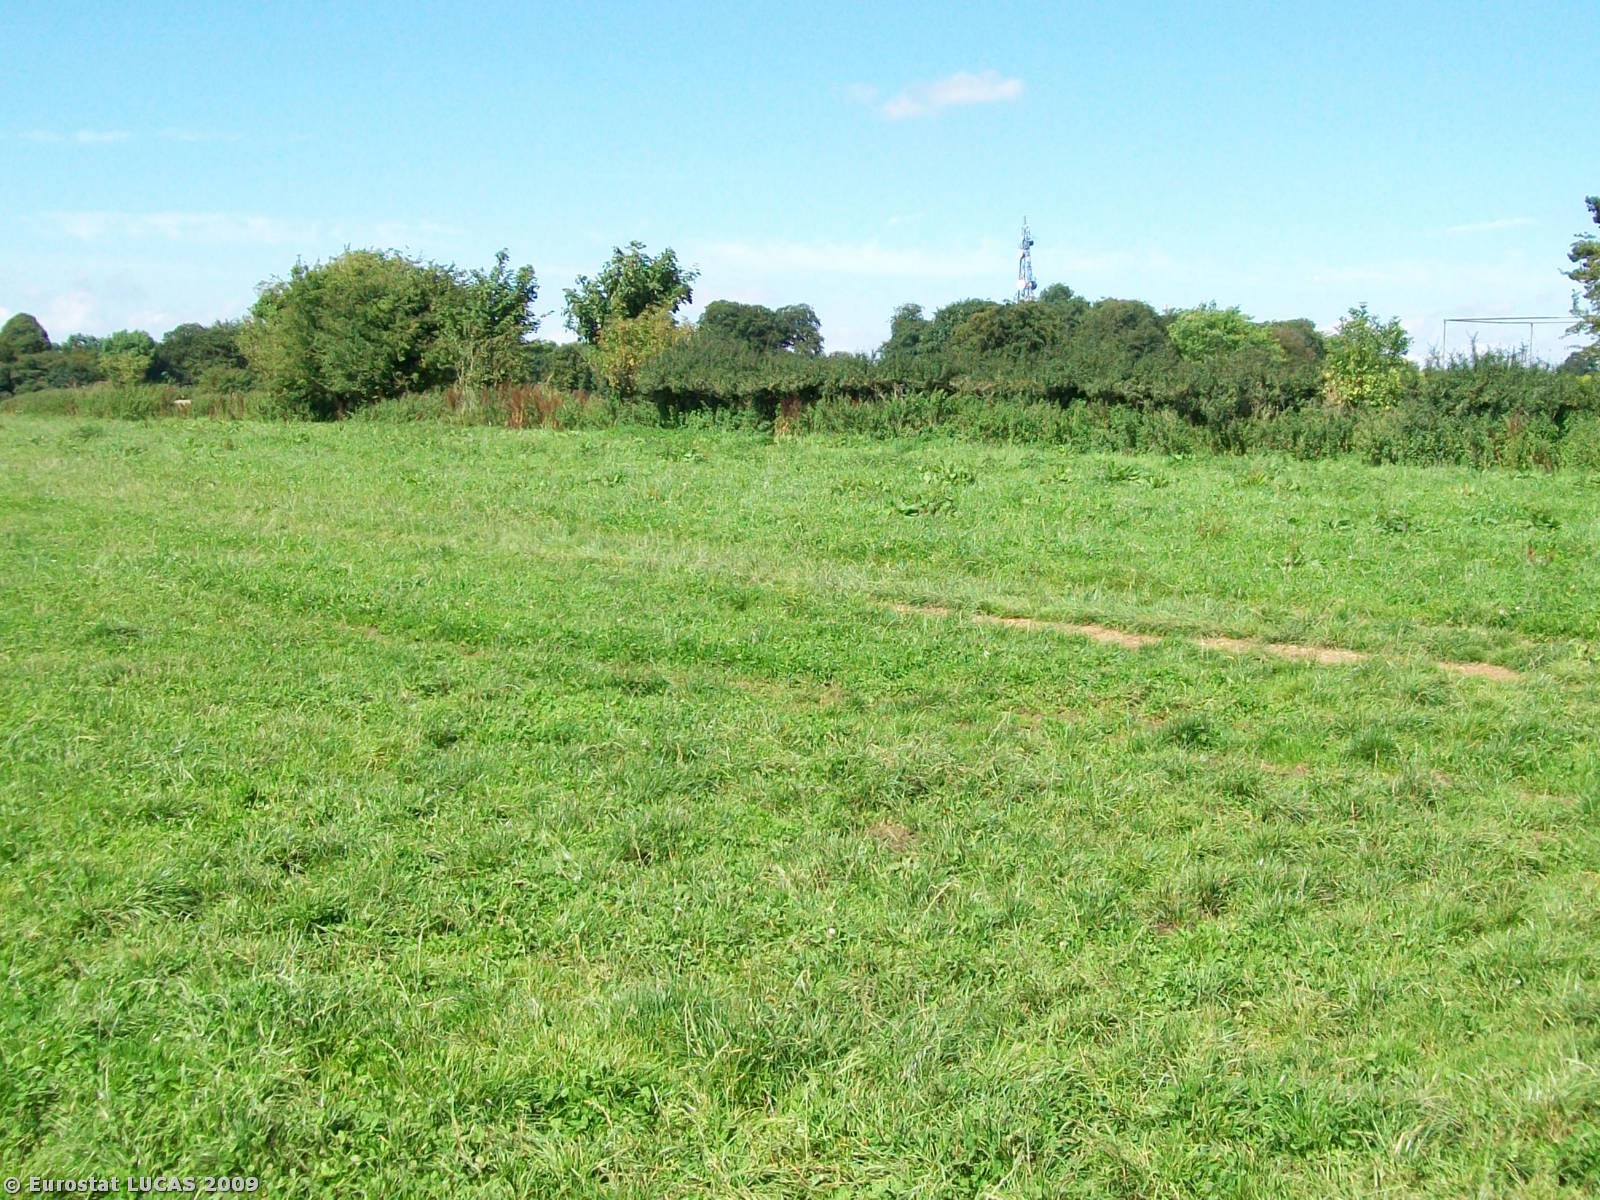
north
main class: Grassland
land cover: Grassland without tree/shrub cover
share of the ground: > 75 %
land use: Agriculture (excluding fallow land and kitchen gardens)
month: August
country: GB
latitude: 50.2031
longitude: -5.1810
